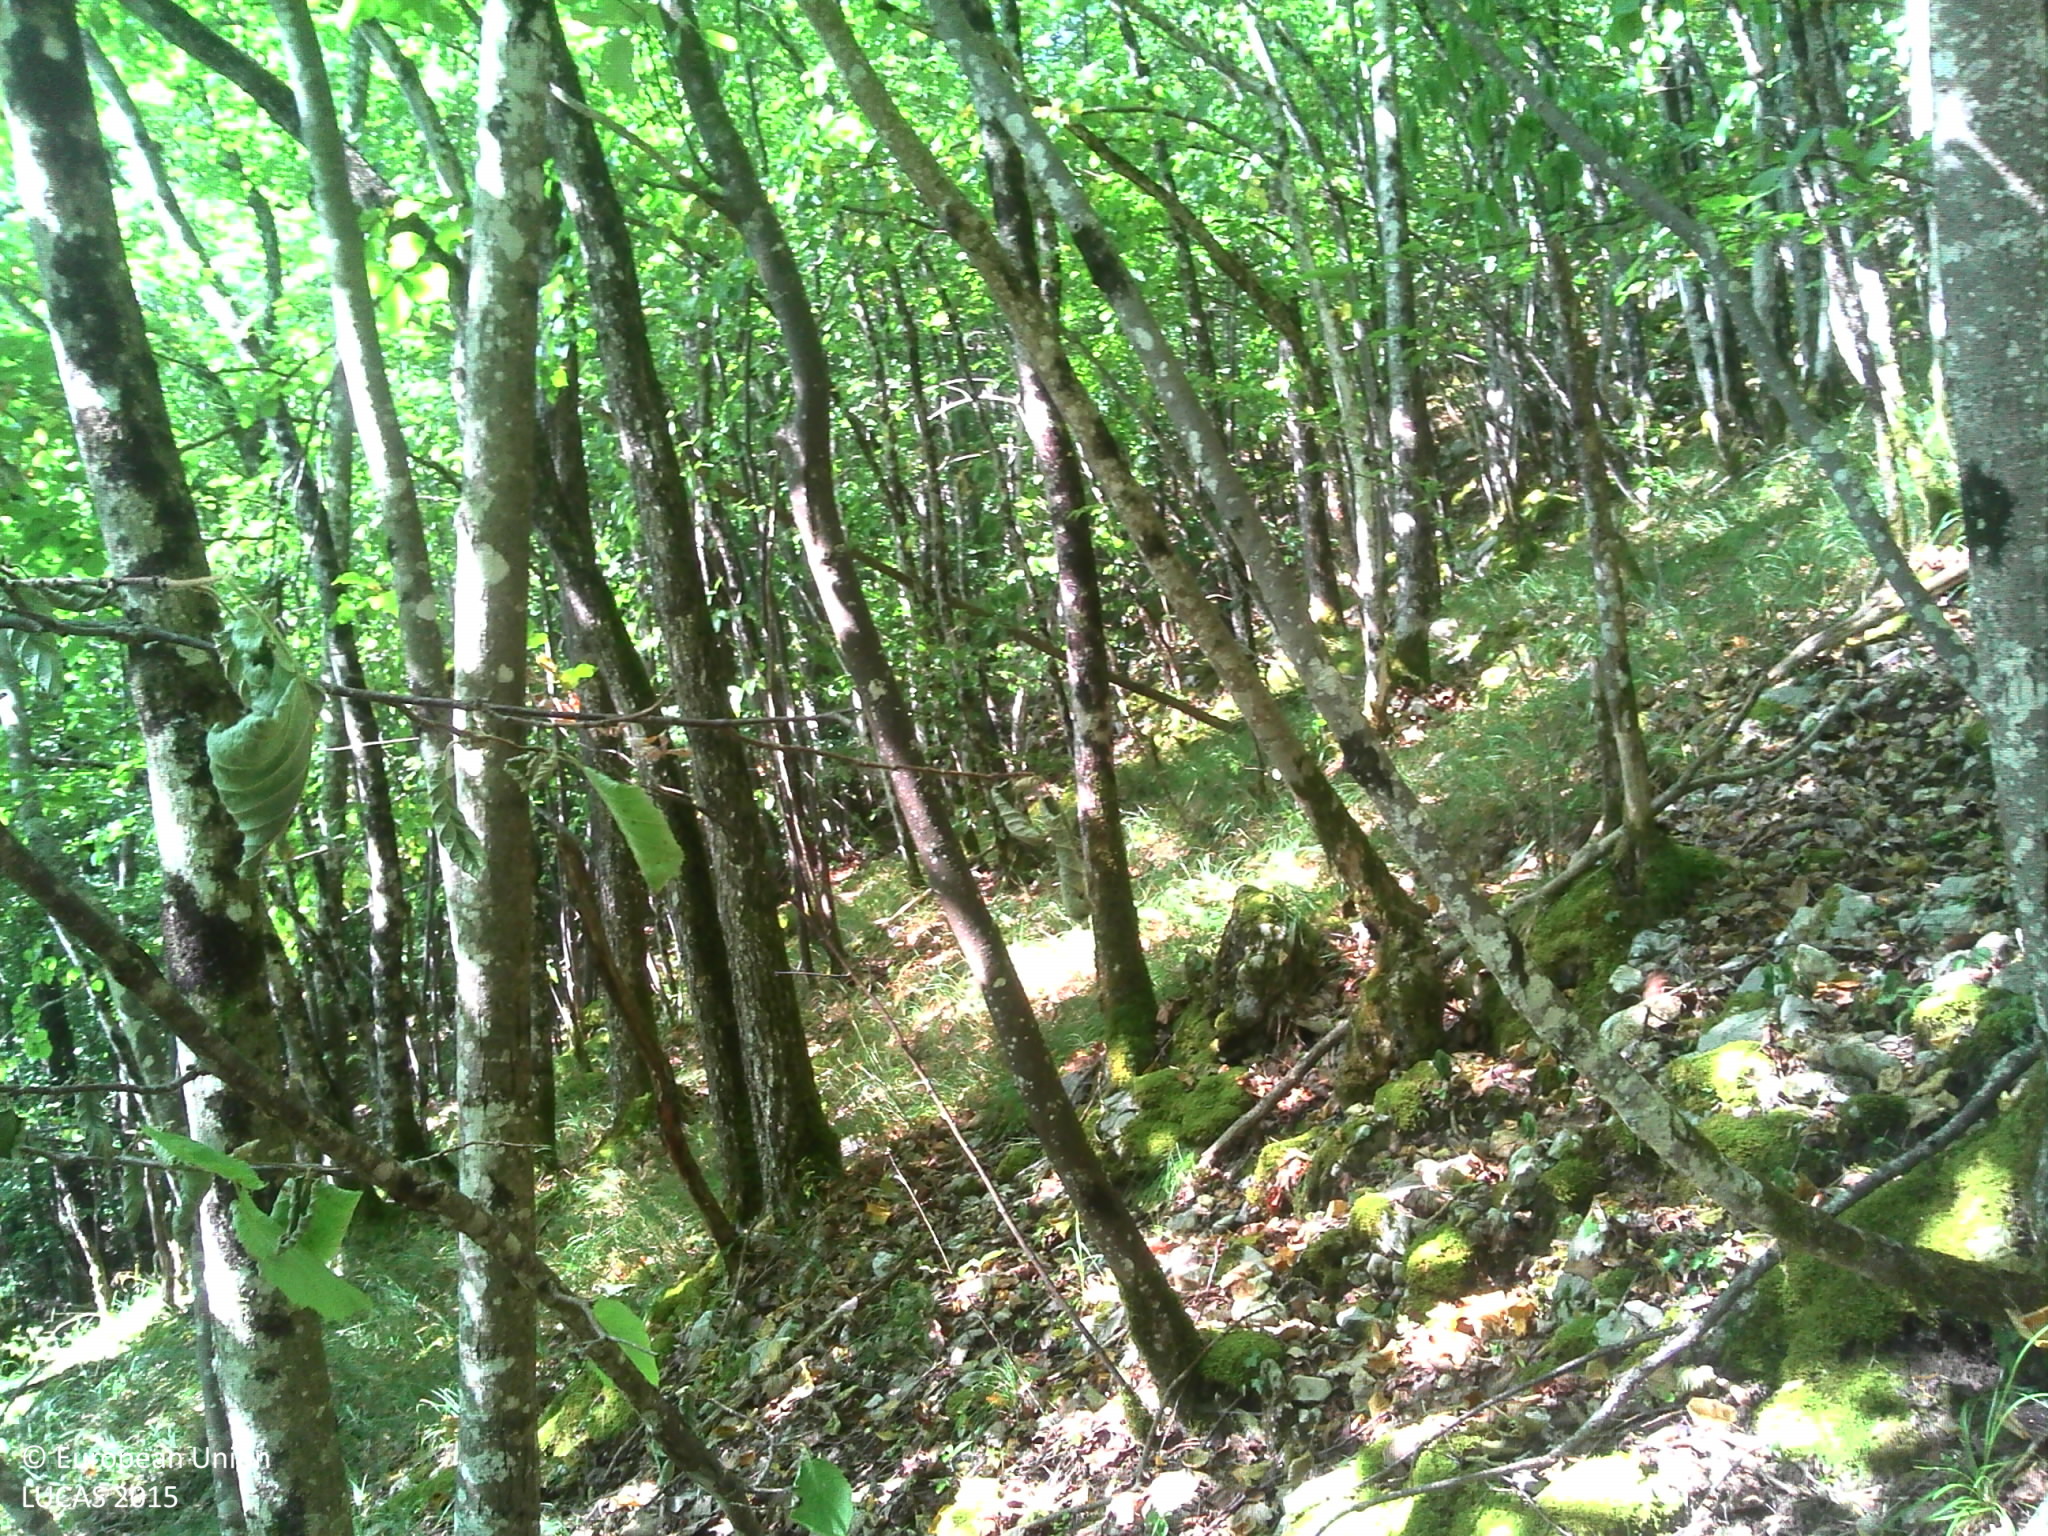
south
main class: Woodland
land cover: Broadleaved woodland
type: beech forest
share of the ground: > 75 %
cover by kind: broadleaved forest trees 90 %, herbaceous plants 5 %, unconsolidated bare surface 5 %
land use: Forestry
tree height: > 5 m
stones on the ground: 10 - 25 %
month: July
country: FR
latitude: 45.8303
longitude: 6.1293
